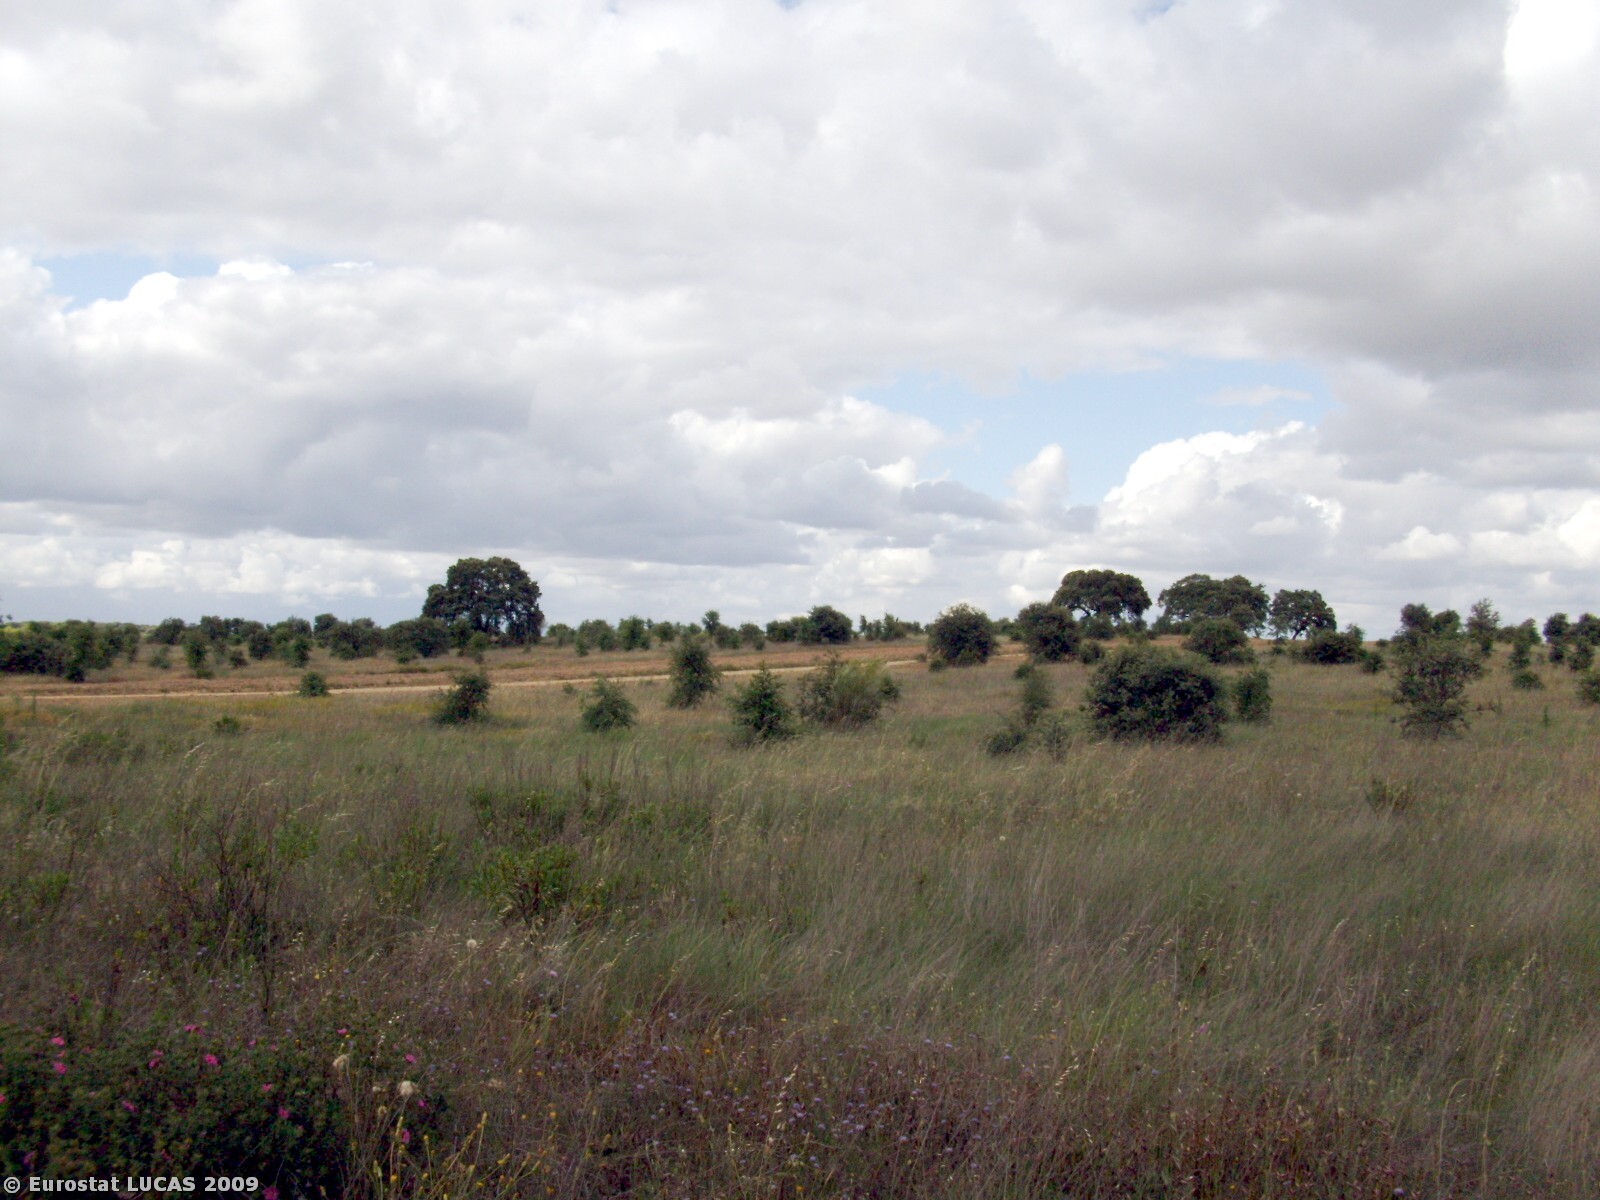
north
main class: Woodland
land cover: Broadleaved woodland
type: broadleaved evergreen forest
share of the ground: 10 - 25 %
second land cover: Spontaneously vegetated surfaces
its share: 50 - 75 %
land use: Forestry
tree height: > 5 m
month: May
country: PT
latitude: 39.2286
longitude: -7.8315
